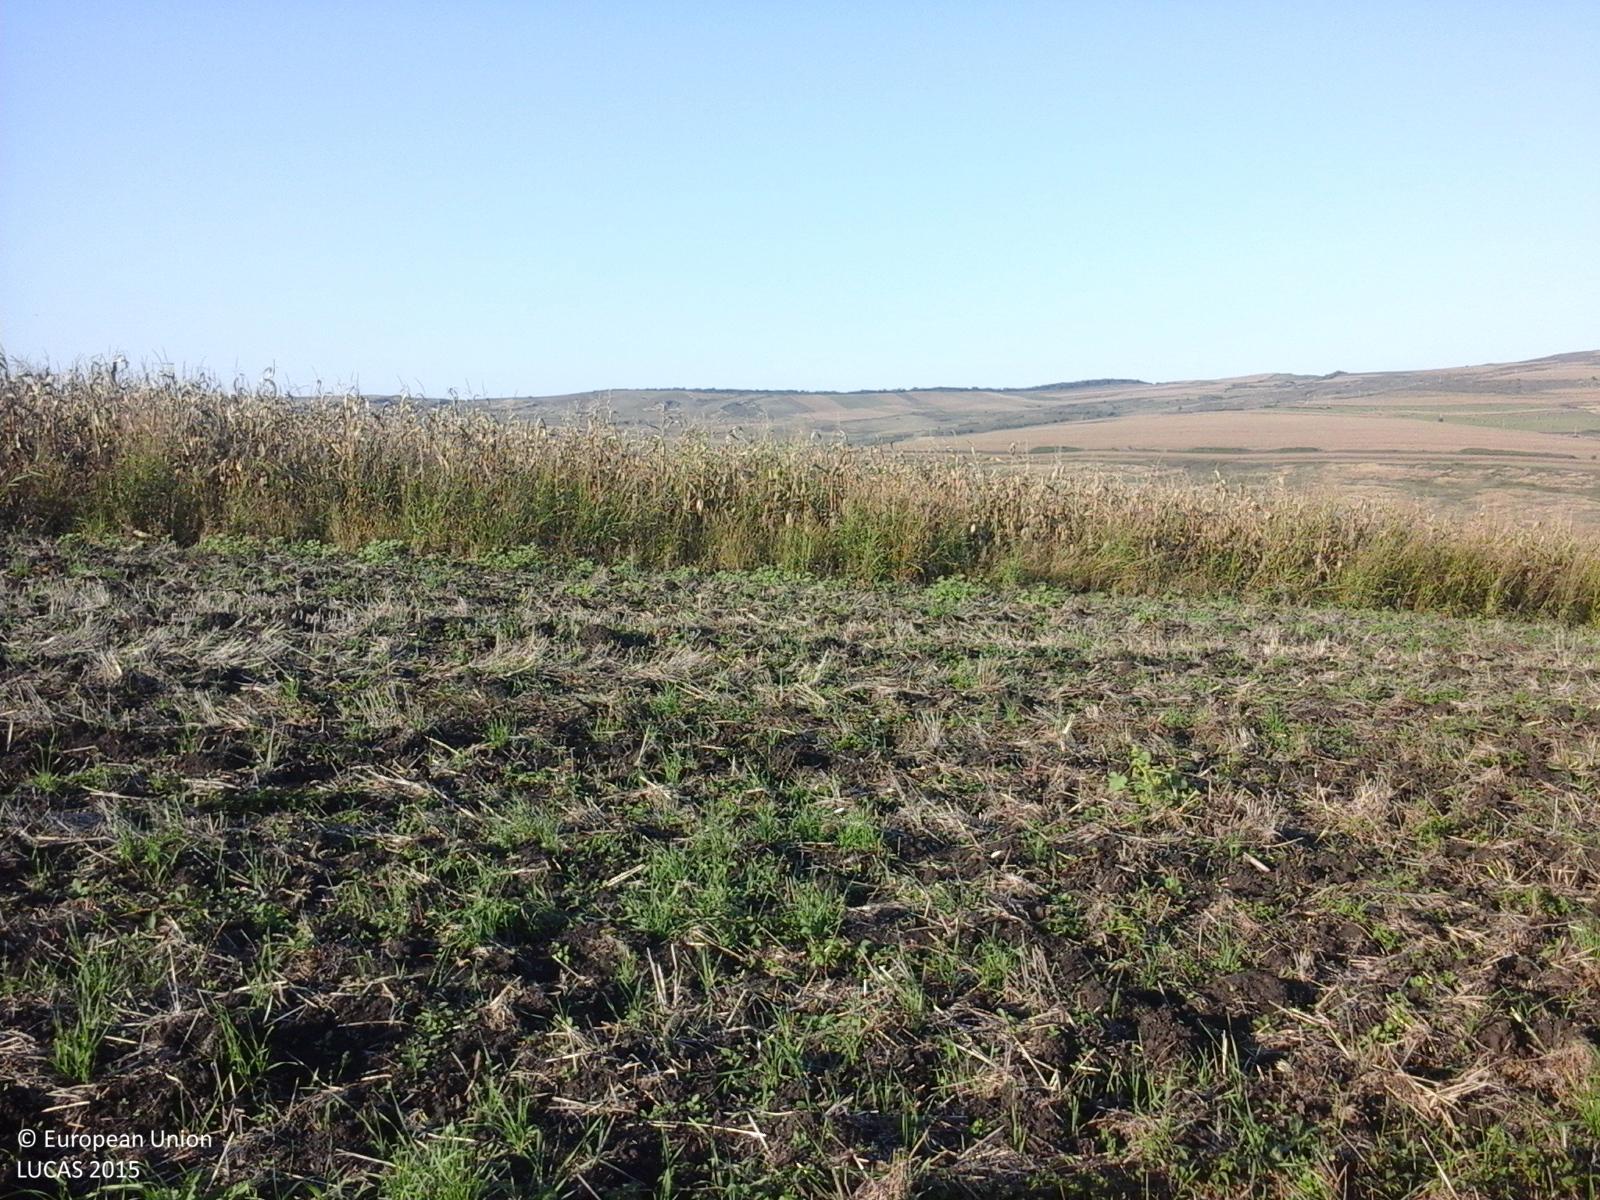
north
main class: Cropland
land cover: Common wheat
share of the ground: 25 - 50 %
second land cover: Spontaneously vegetated surfaces
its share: 25 - 50 %
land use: Agriculture (excluding fallow land and kitchen gardens)
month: October
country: RO
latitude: 46.2219
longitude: 23.7741
